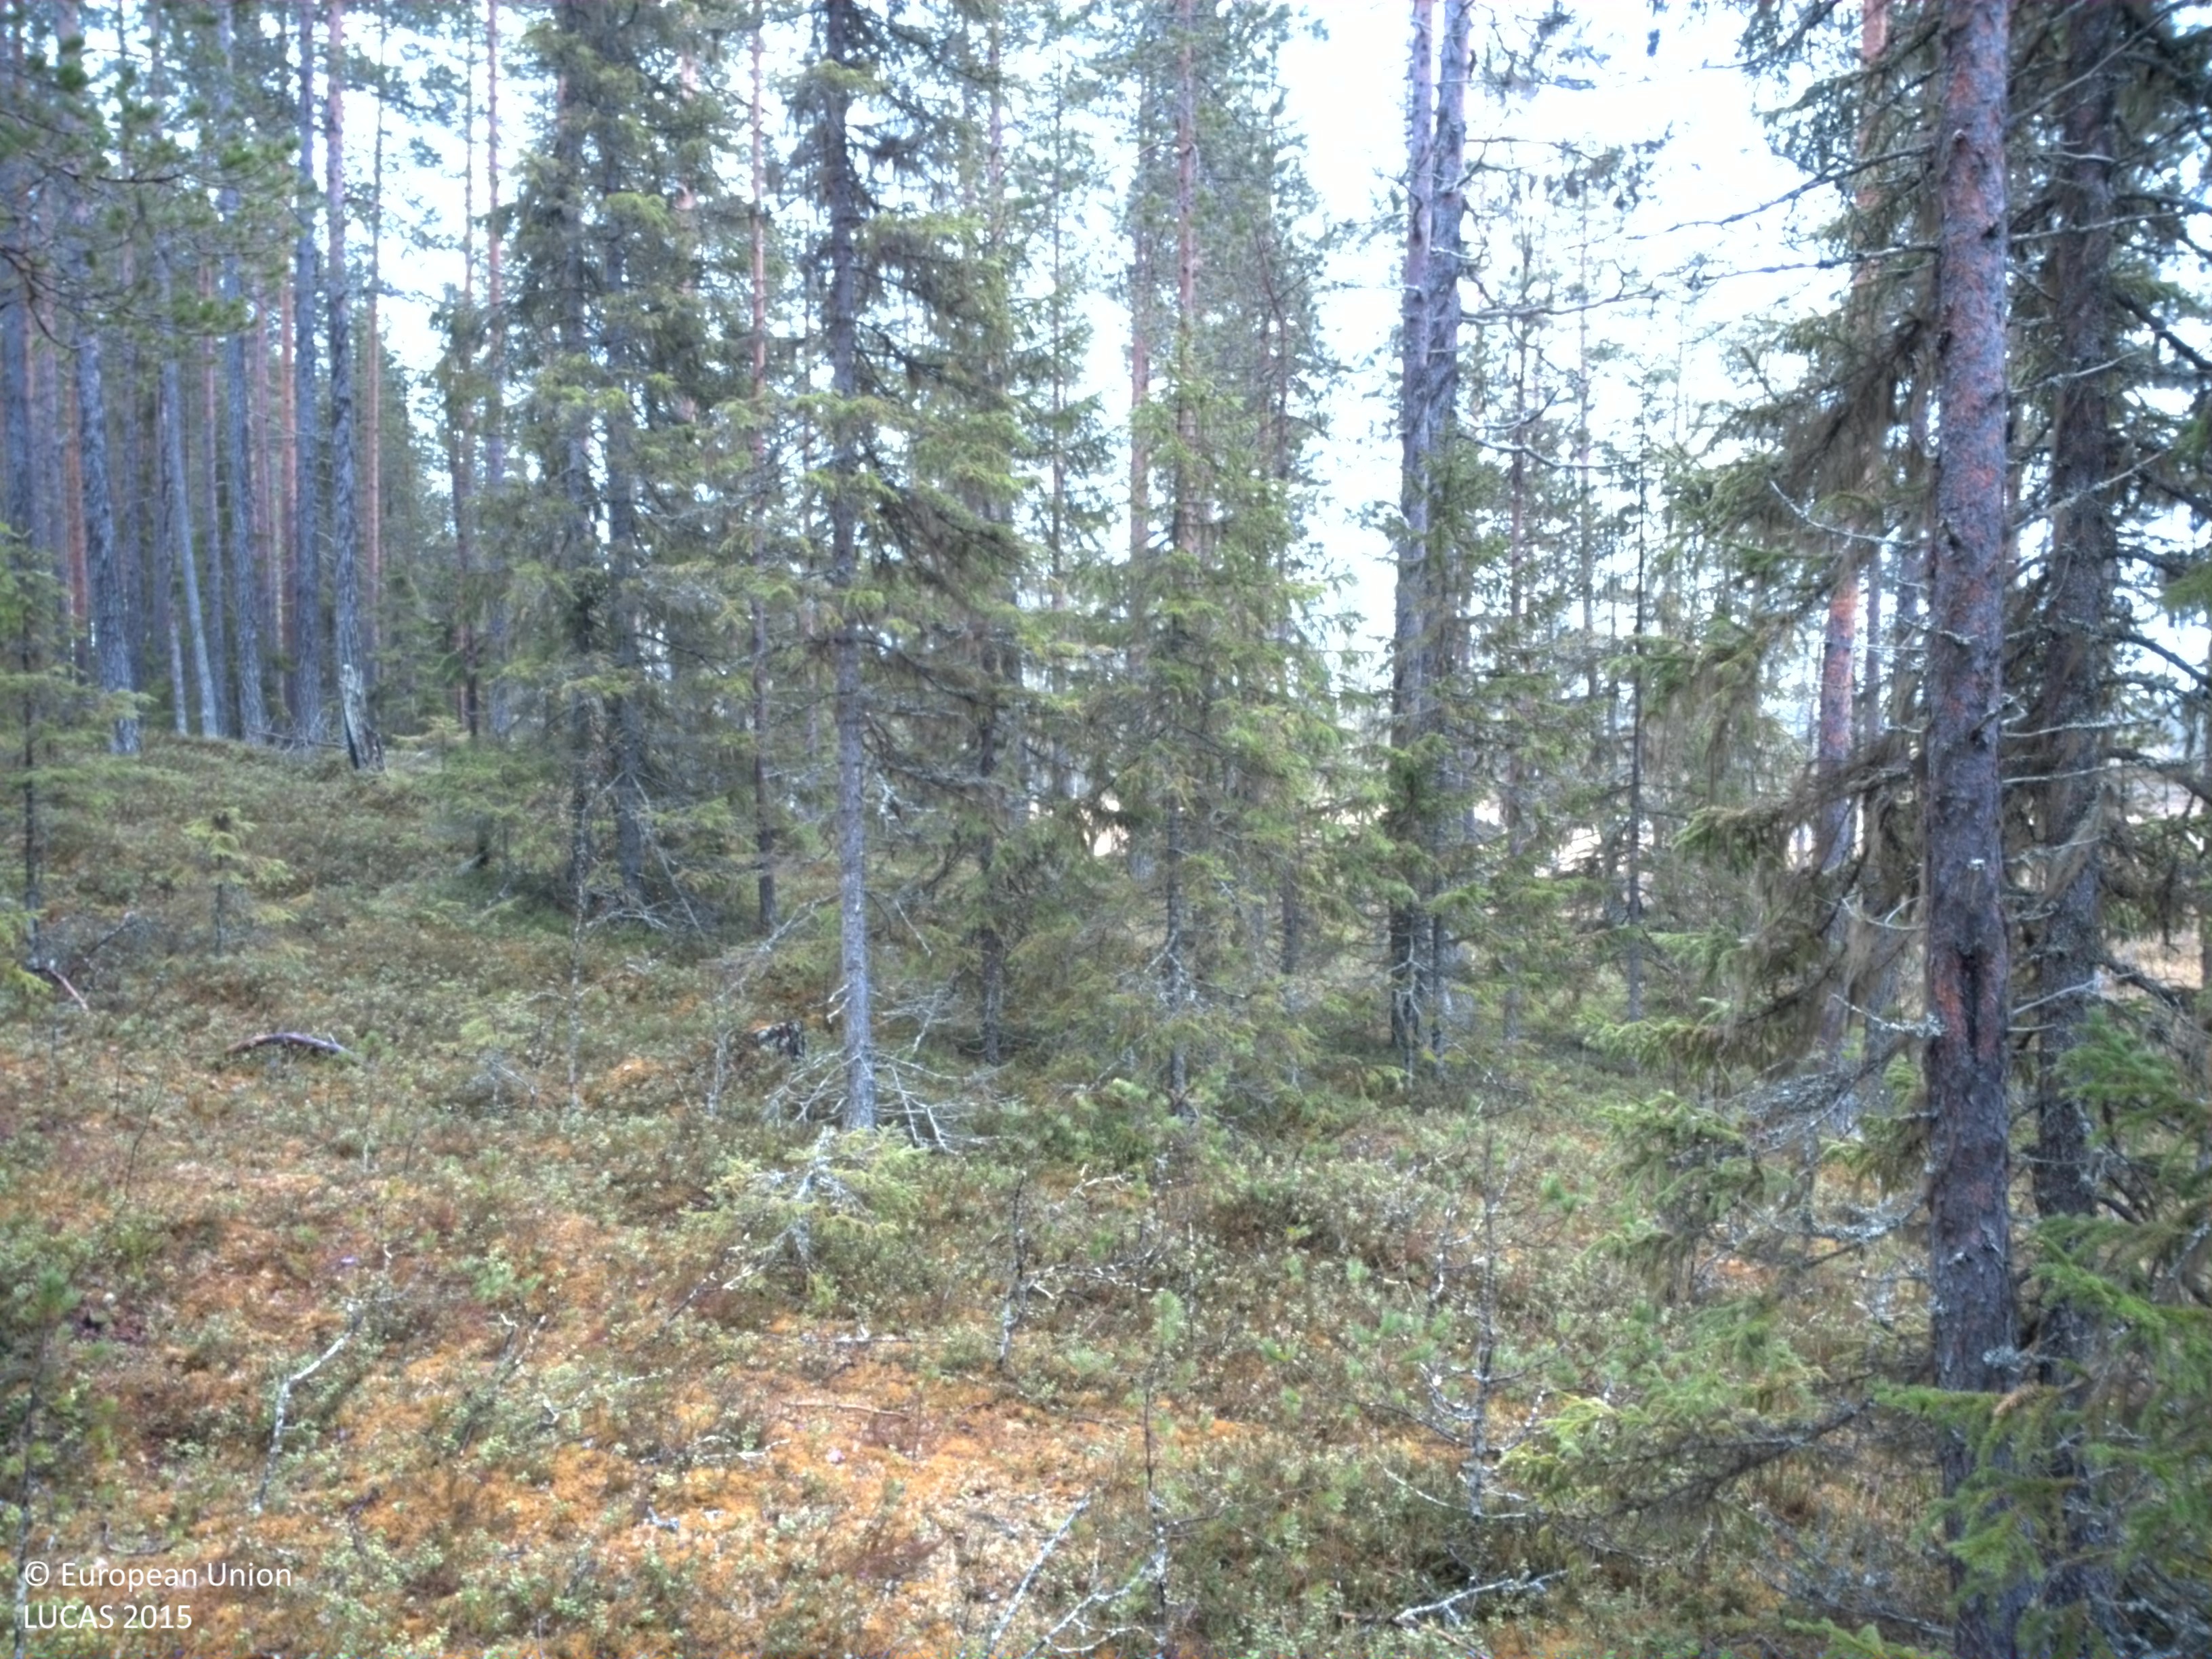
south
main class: Woodland
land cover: Pine dominated coniferous woodland
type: boreal forest
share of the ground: > 75 %
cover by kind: coniferous forest trees 80 %, broadleaved forest trees 10 %, shrubs 10 %
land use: Forestry
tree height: > 5 m
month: June
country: SE
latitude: 63.3924
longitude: 14.5610
